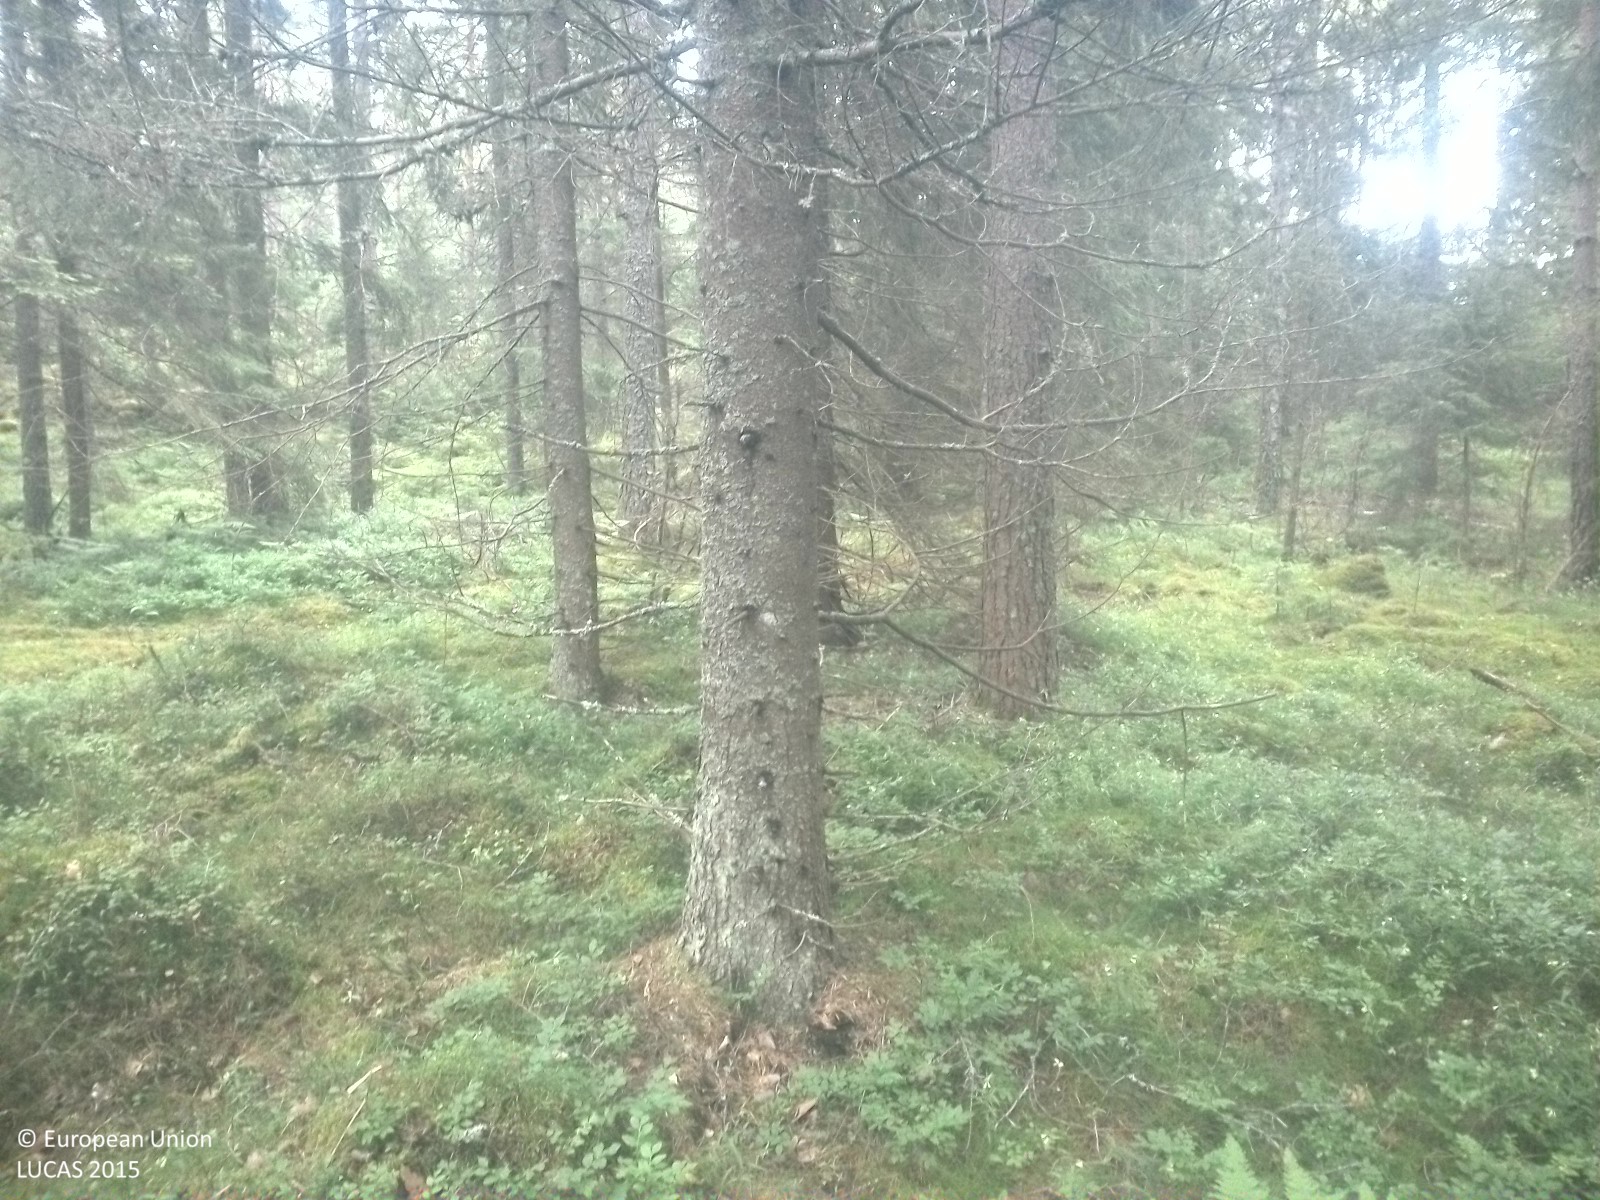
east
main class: Woodland
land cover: Other mixed woodland
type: boreal forest
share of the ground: 25 - 50 %
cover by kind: herbaceous plants 25 %, lichens and mosses 25 %, coniferous forest trees 20 %, broadleaved forest trees 20 %, shrubs 10 %
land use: Forestry
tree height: > 5 m
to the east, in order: Other mixed woodland; Pine dominated mixed woodland; Ditches and canals; Spruce dominated mixed woodland; Ditches and canals; Grass margins; Paved roads, cycling and walking lanes; Other mixed woodland
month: July
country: SE
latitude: 58.9194
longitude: 15.0116
